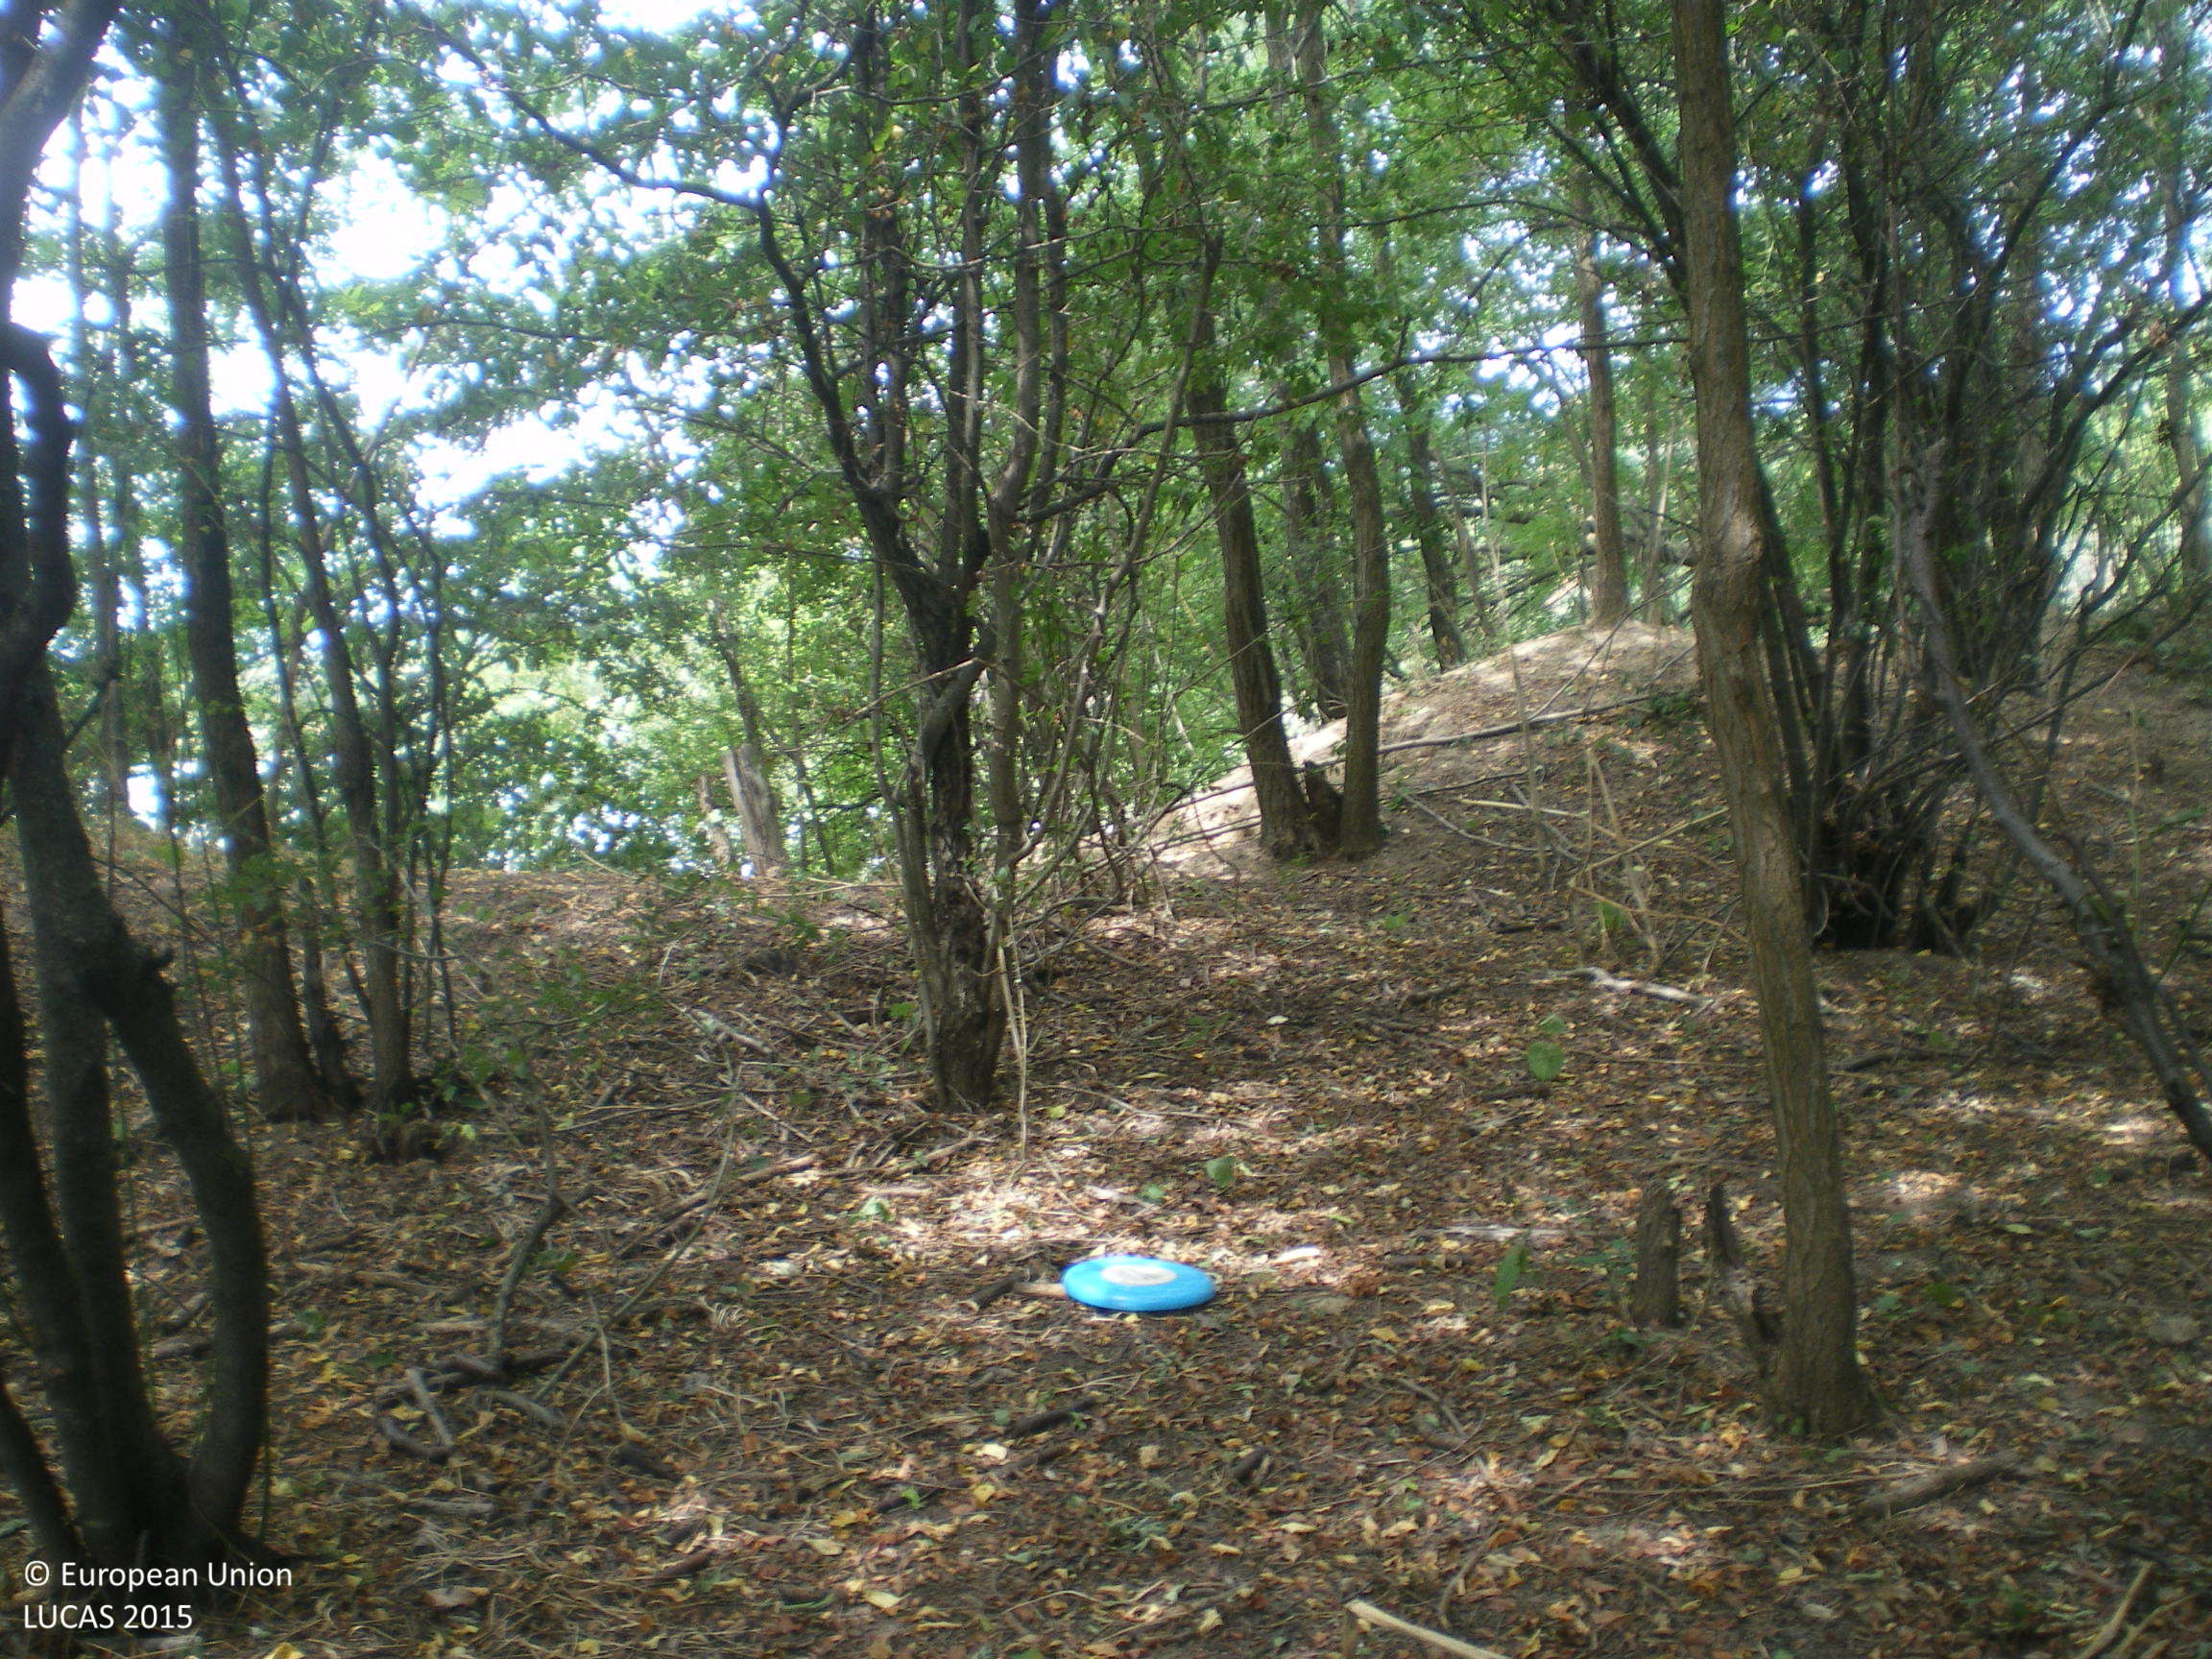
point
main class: Woodland
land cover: Broadleaved woodland
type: mesophytic deciduous forest
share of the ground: > 75 %
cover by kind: broadleaved forest trees 90 %, shrubs 5 %, herbaceous plants 5 %
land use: Forestry
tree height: > 5 m
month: August
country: BG
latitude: 42.5562
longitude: 25.6017
